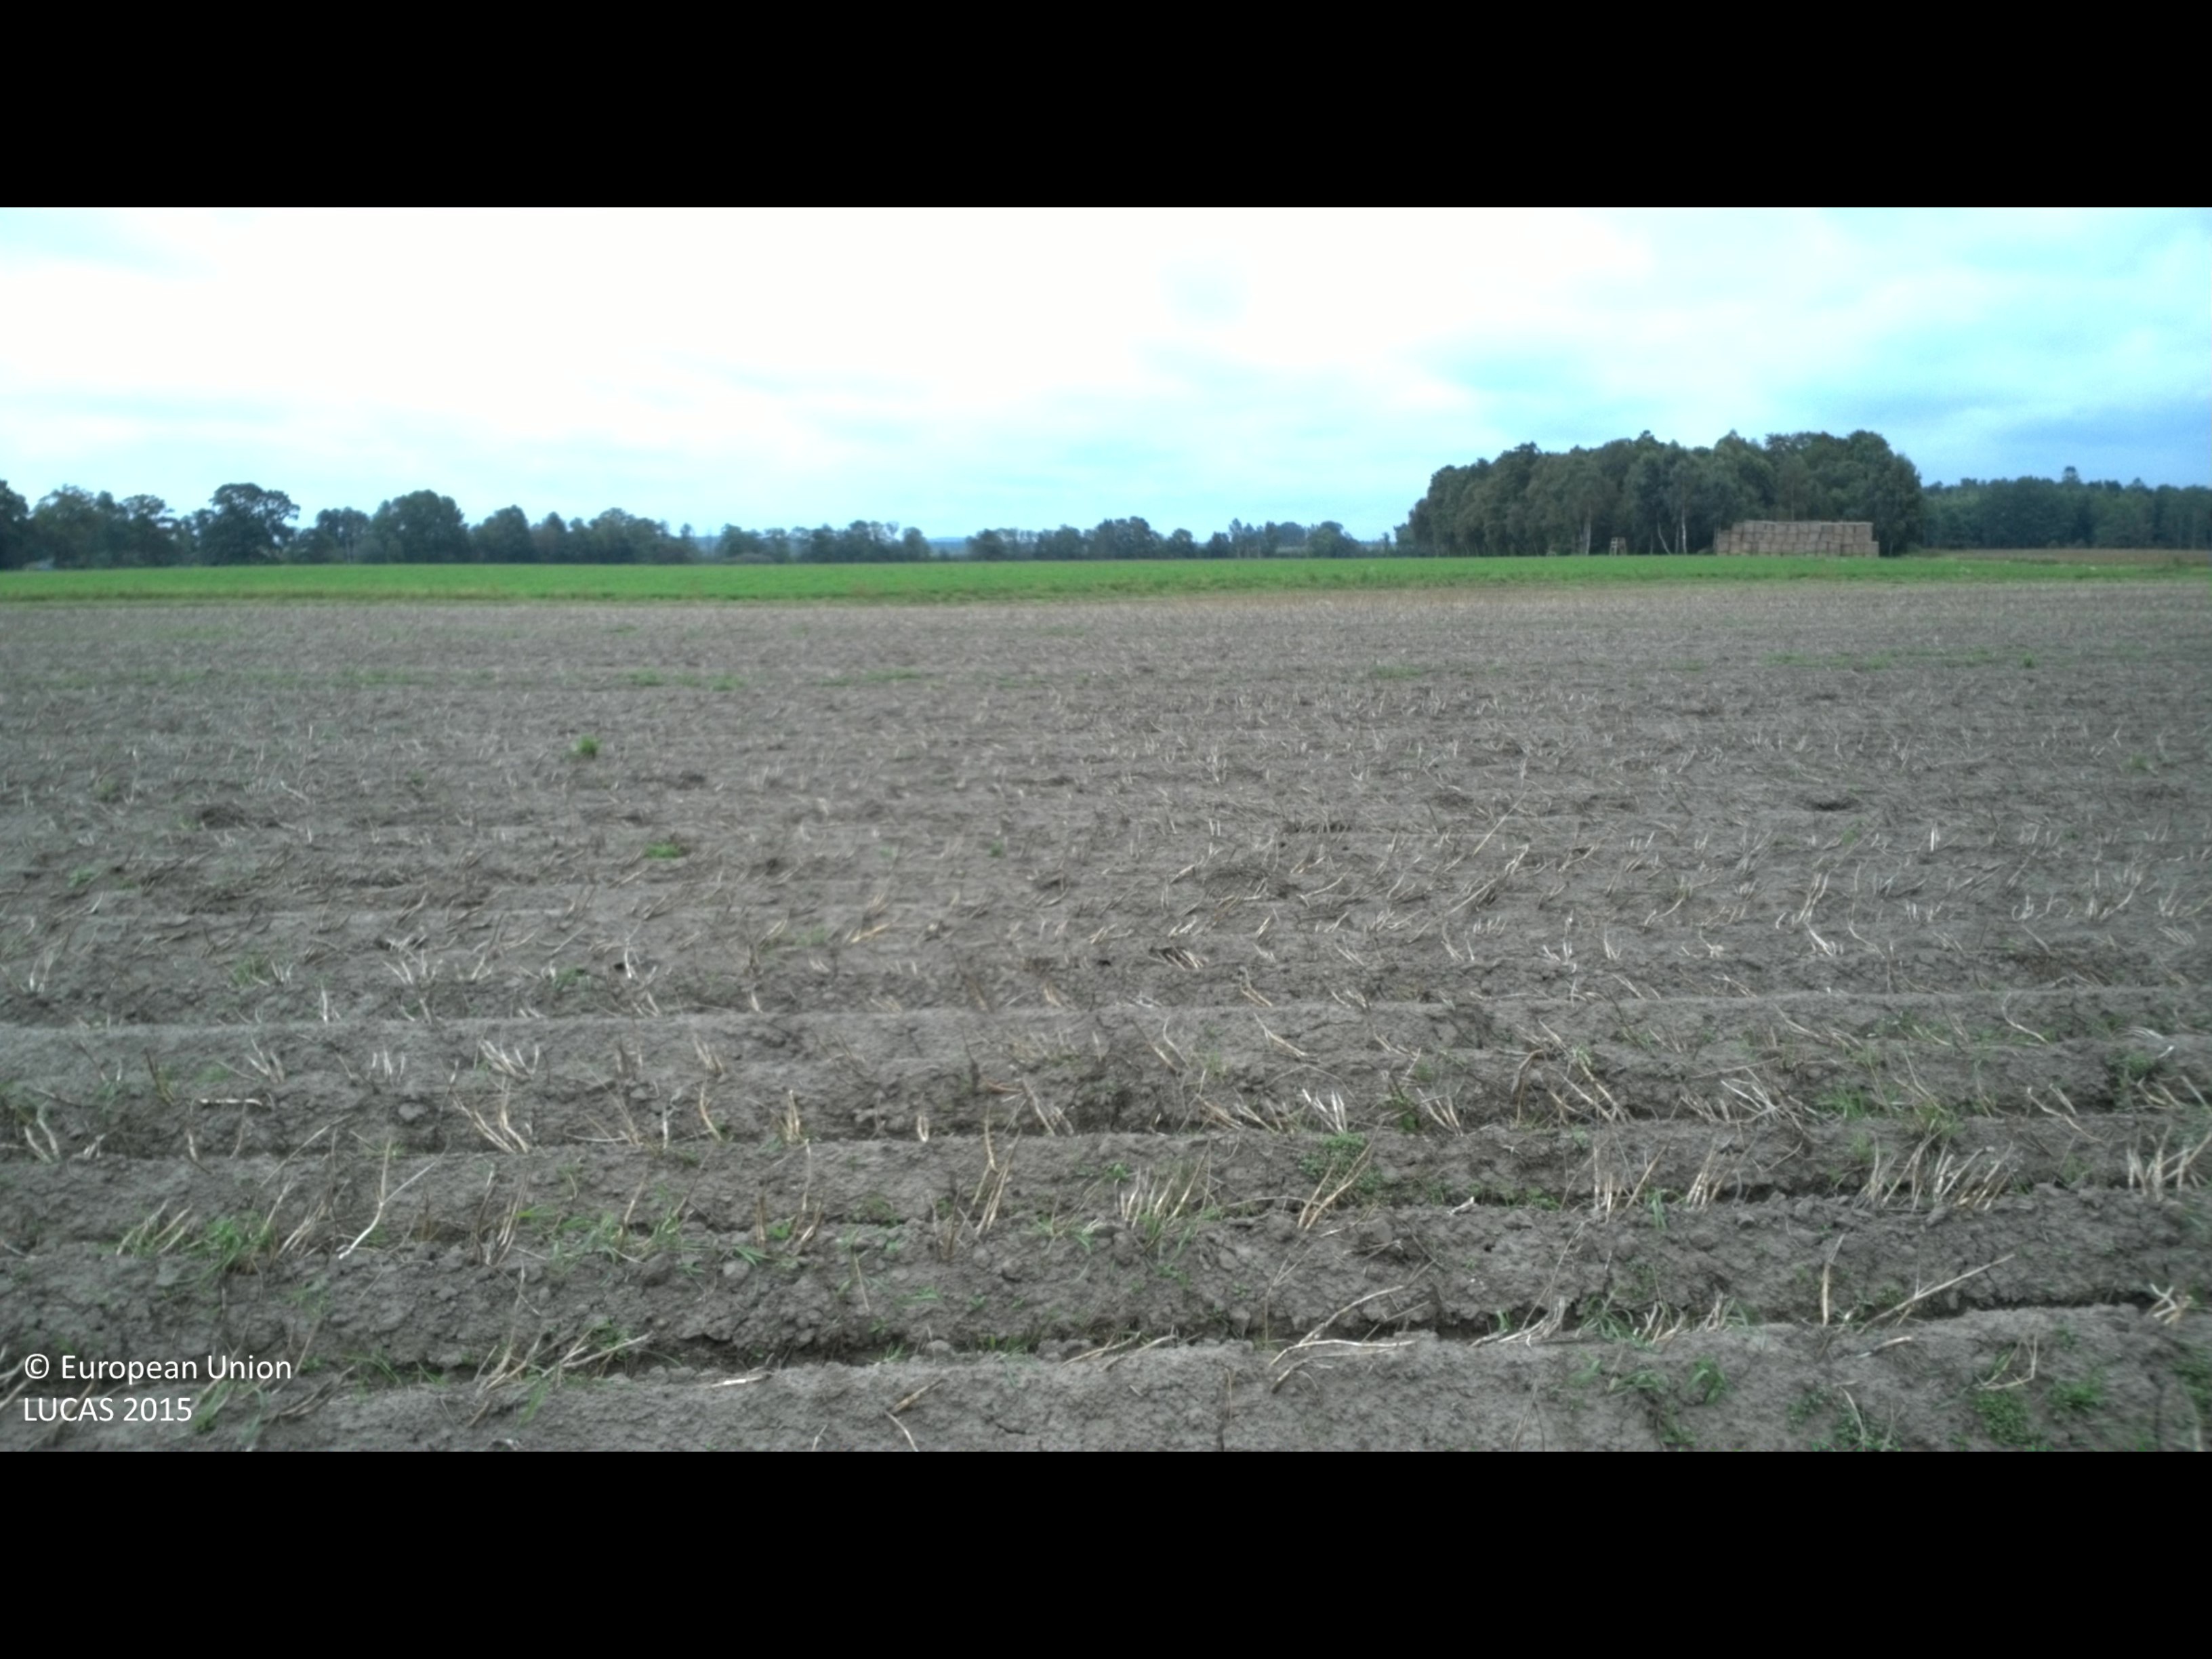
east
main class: Cropland
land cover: Potatoes
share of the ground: < 10 %
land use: Agriculture (excluding fallow land and kitchen gardens)
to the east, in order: Potatoes; Other bare soil; Grass margins; Other root crops
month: September
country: SE
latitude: 56.1762
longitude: 14.1053
